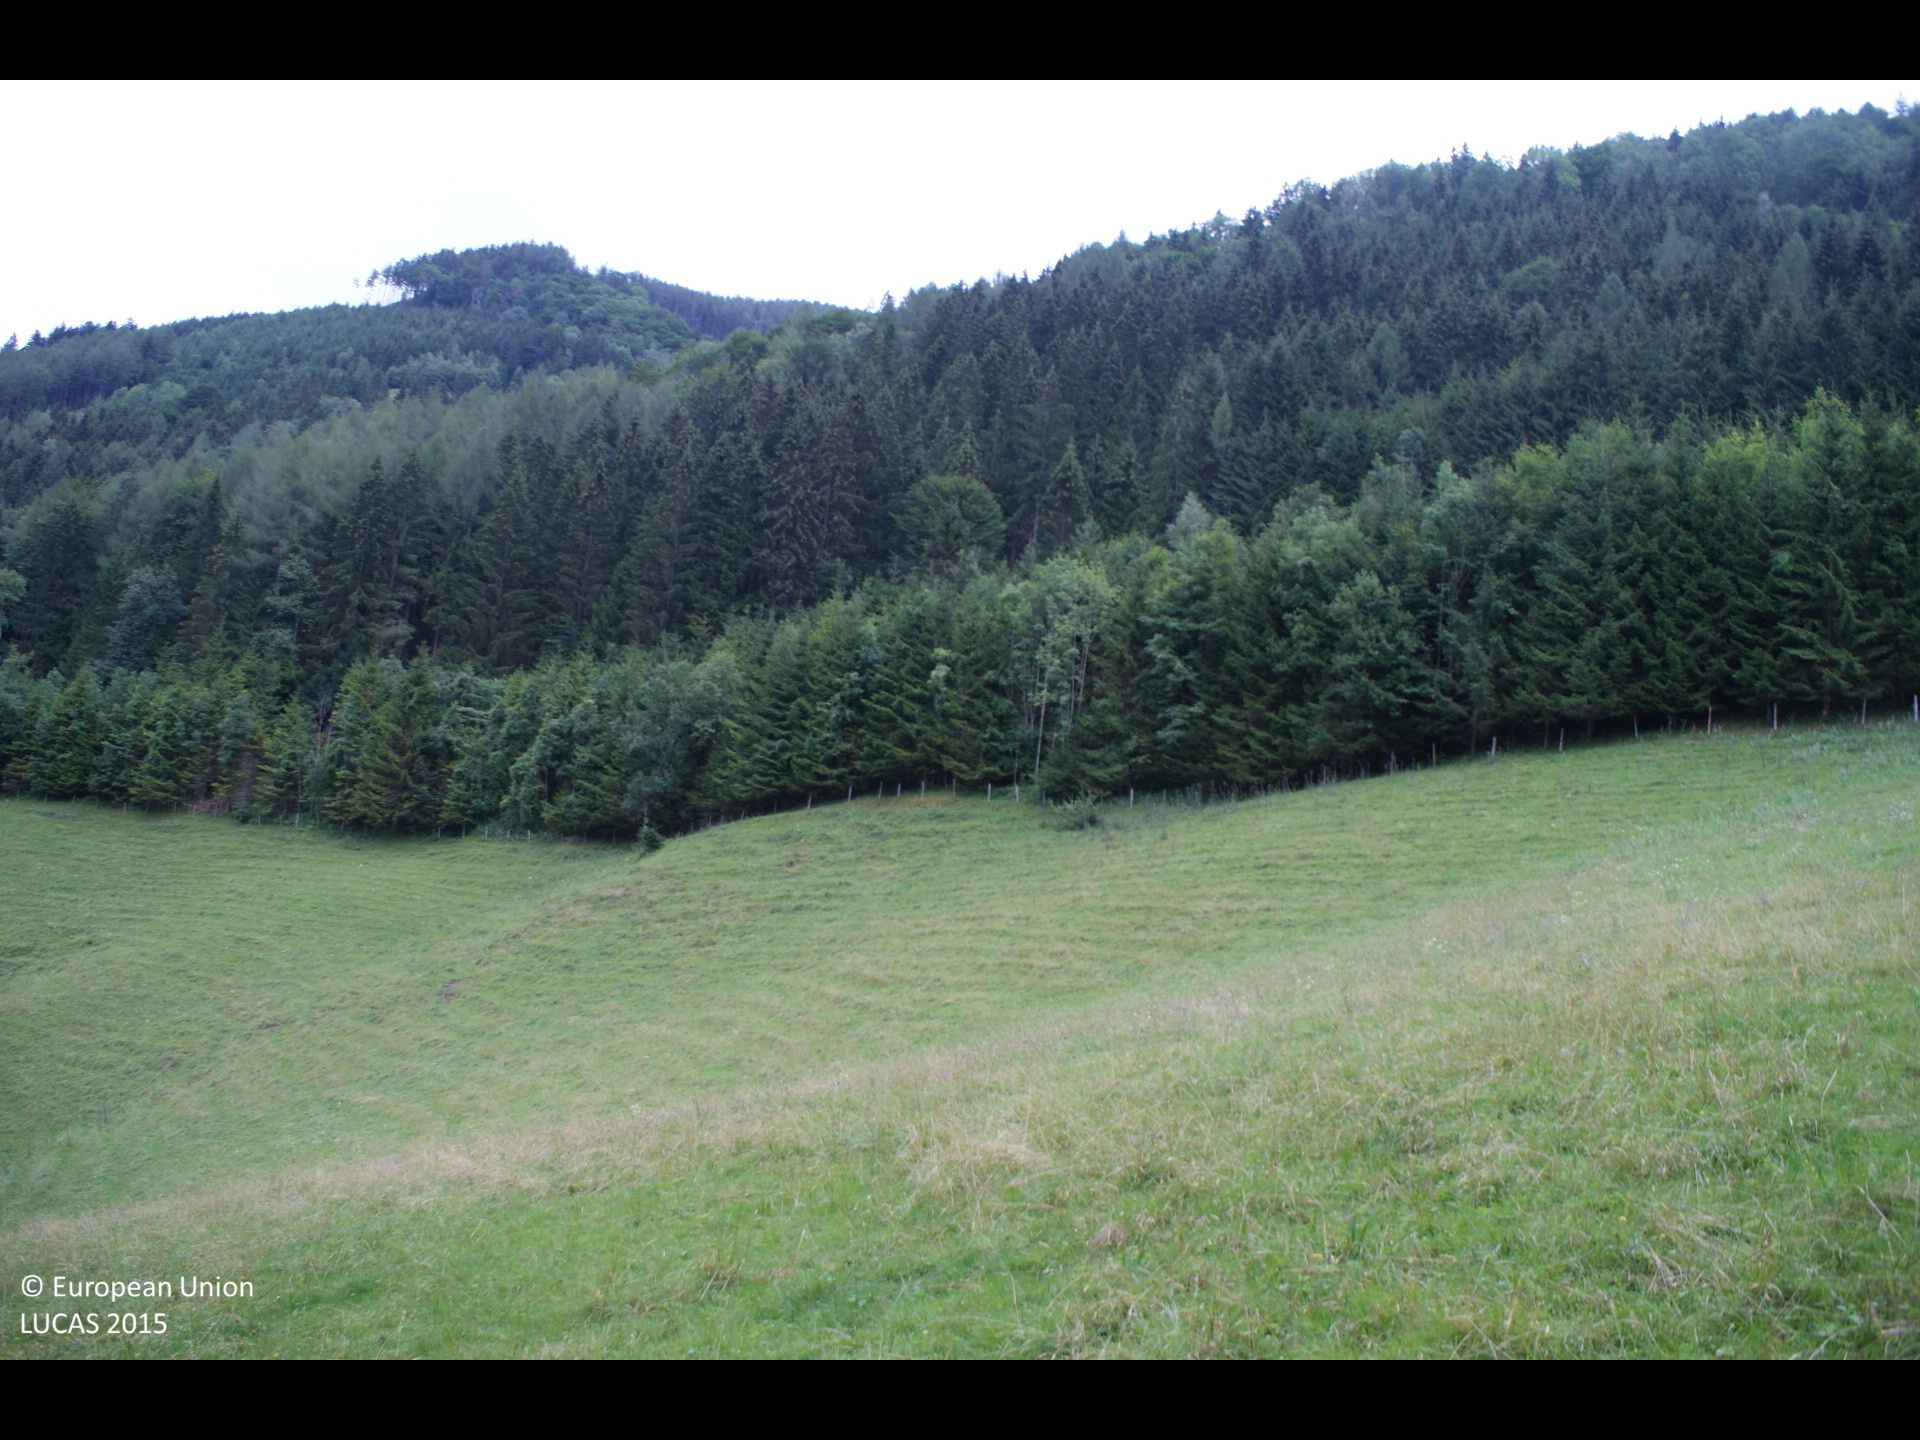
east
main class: Grassland
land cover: Grassland without tree/shrub cover
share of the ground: > 75 %
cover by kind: herbaceous plants 100 %
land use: Agriculture (excluding fallow land and kitchen gardens)
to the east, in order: Grassland without tree/shrub cover; Fences; Spruce dominated coniferous woodland; Tracks; Shrubland with sparse tree cover; Spruce dominated coniferous woodland; Tracks; Spruce dominated coniferous woodland; Grass margins; Tracks; Spruce dominated coniferous woodland
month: July
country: AT
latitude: 47.8787
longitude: 14.9345
